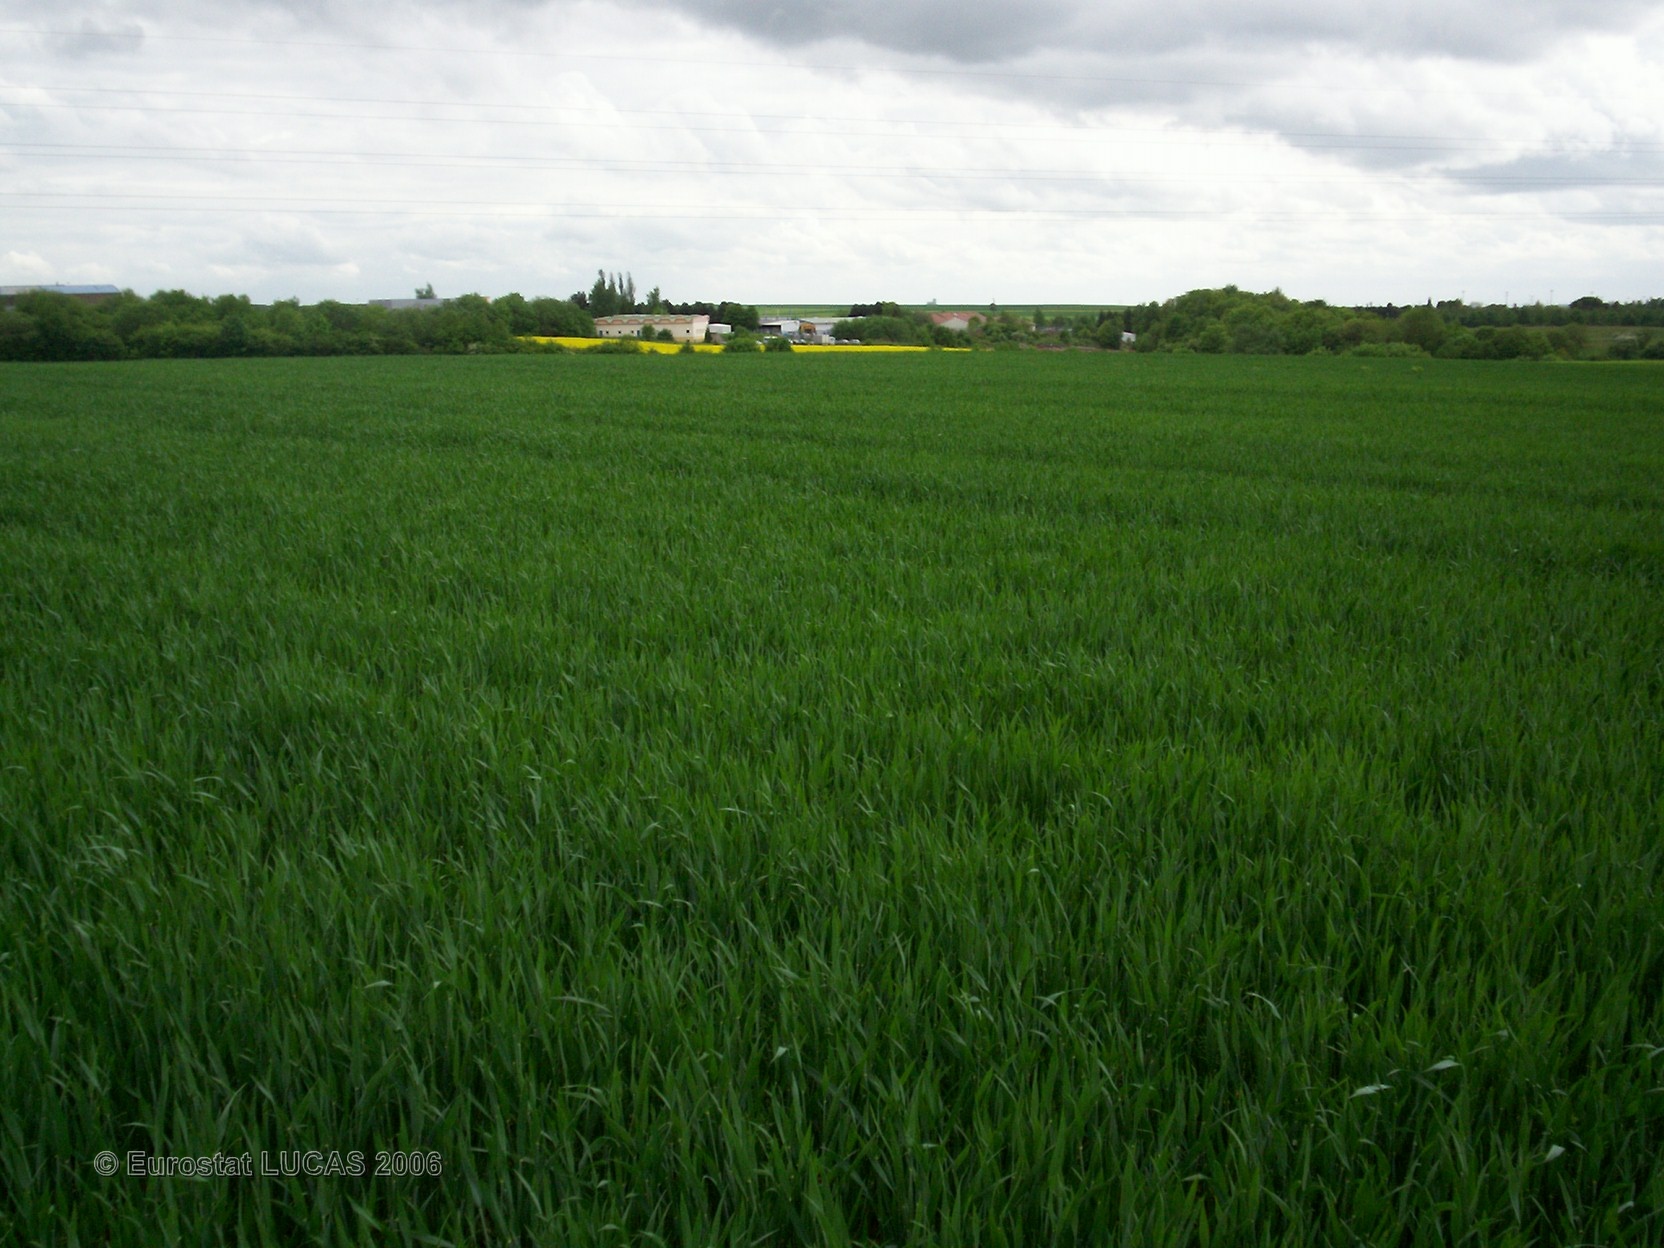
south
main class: Cropland
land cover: Common wheat
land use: Agriculture (excluding fallow land and kitchen gardens)
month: May
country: FR
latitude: 49.4783
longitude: 5.8447
